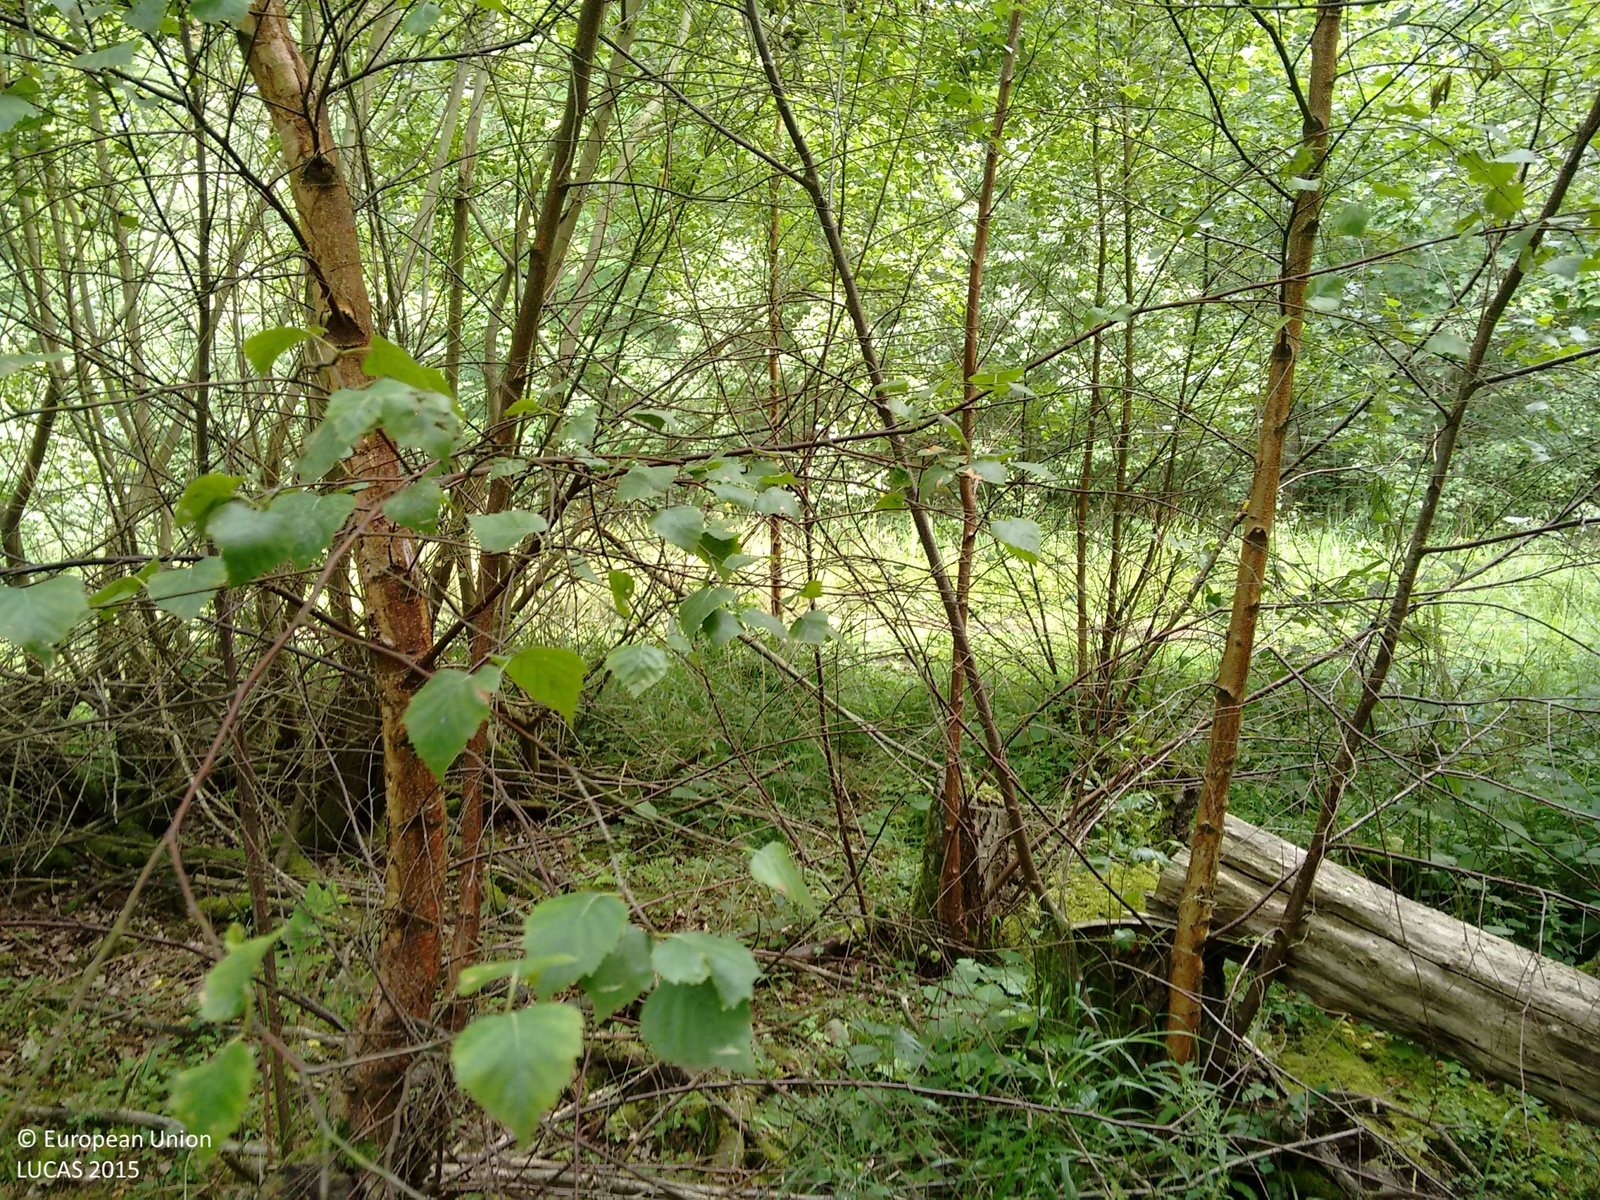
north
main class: Woodland
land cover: Other mixed woodland
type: mesophytic deciduous forest
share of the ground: > 75 %
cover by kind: broadleaved forest trees 70 %, coniferous forest trees 30 %
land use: Forestry
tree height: > 5 m
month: July
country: GB
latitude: 52.4769
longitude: -0.6553
